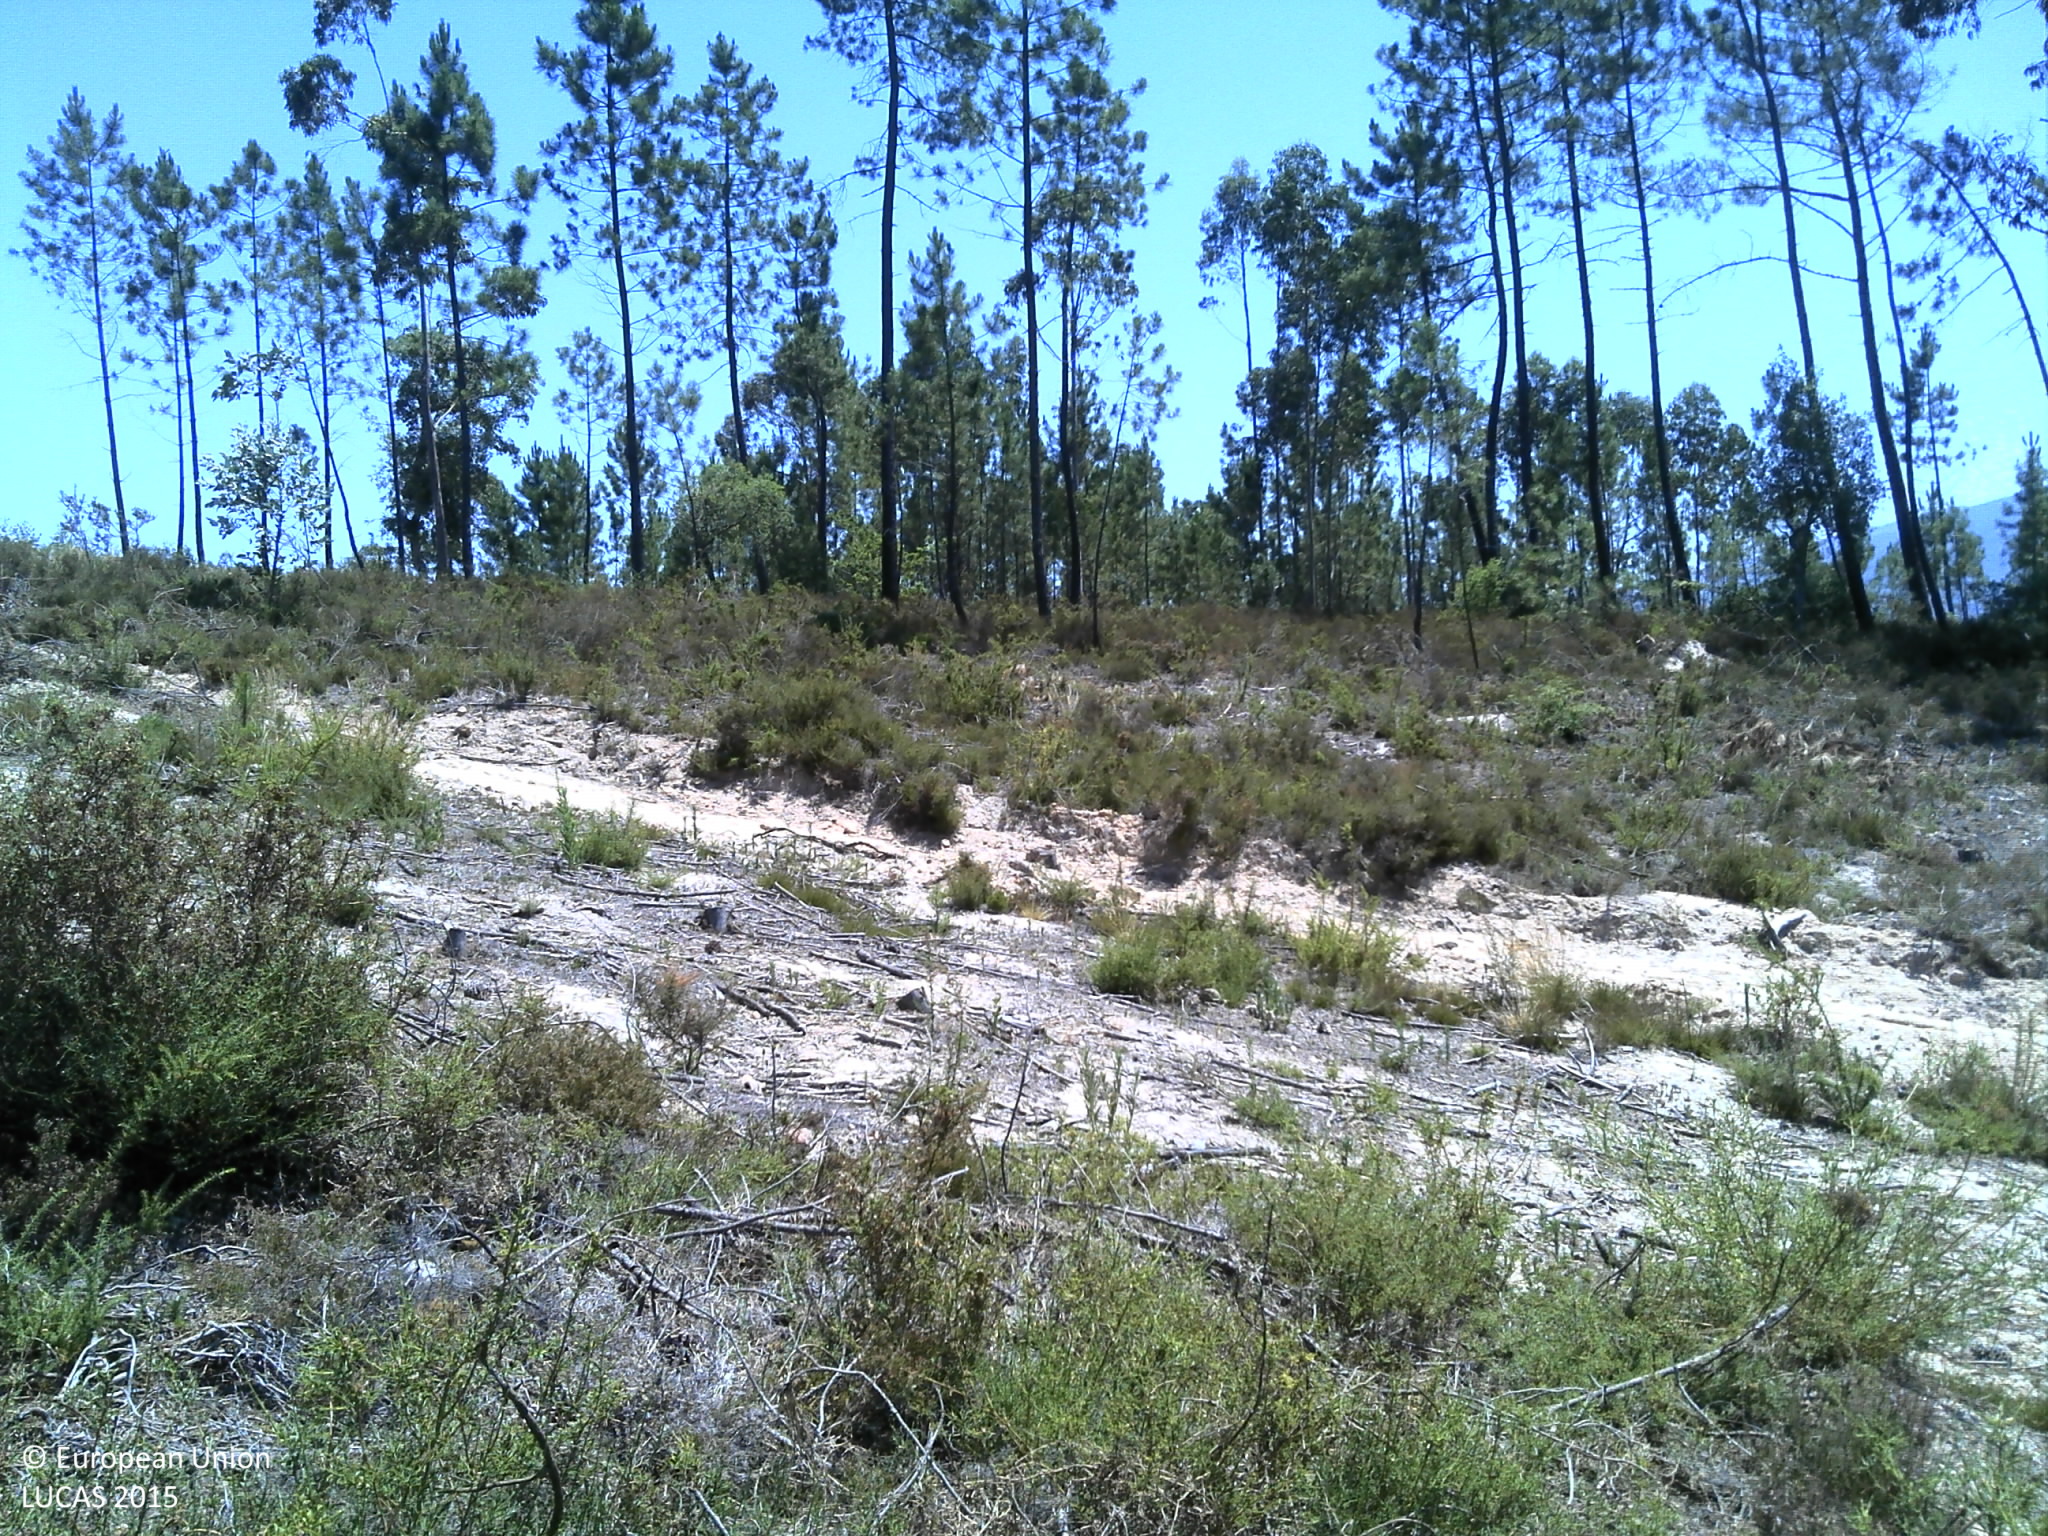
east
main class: Shrubland
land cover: Shrubland without tree cover
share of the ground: > 75 %
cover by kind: shrubs 90 %, unconsolidated bare surface 10 %
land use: Abandoned areas
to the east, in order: Shrubland without tree cover; Tracks; Shrubland without tree cover; Pine dominated coniferous woodland; Tracks; Shrubland without tree cover; Pine dominated coniferous woodland; Pine dominated mixed woodland; Tracks; Broadleaved woodland; Pine dominated mixed woodland; Broadleaved woodland
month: June
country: PT
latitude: 40.1457
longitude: -8.2603
